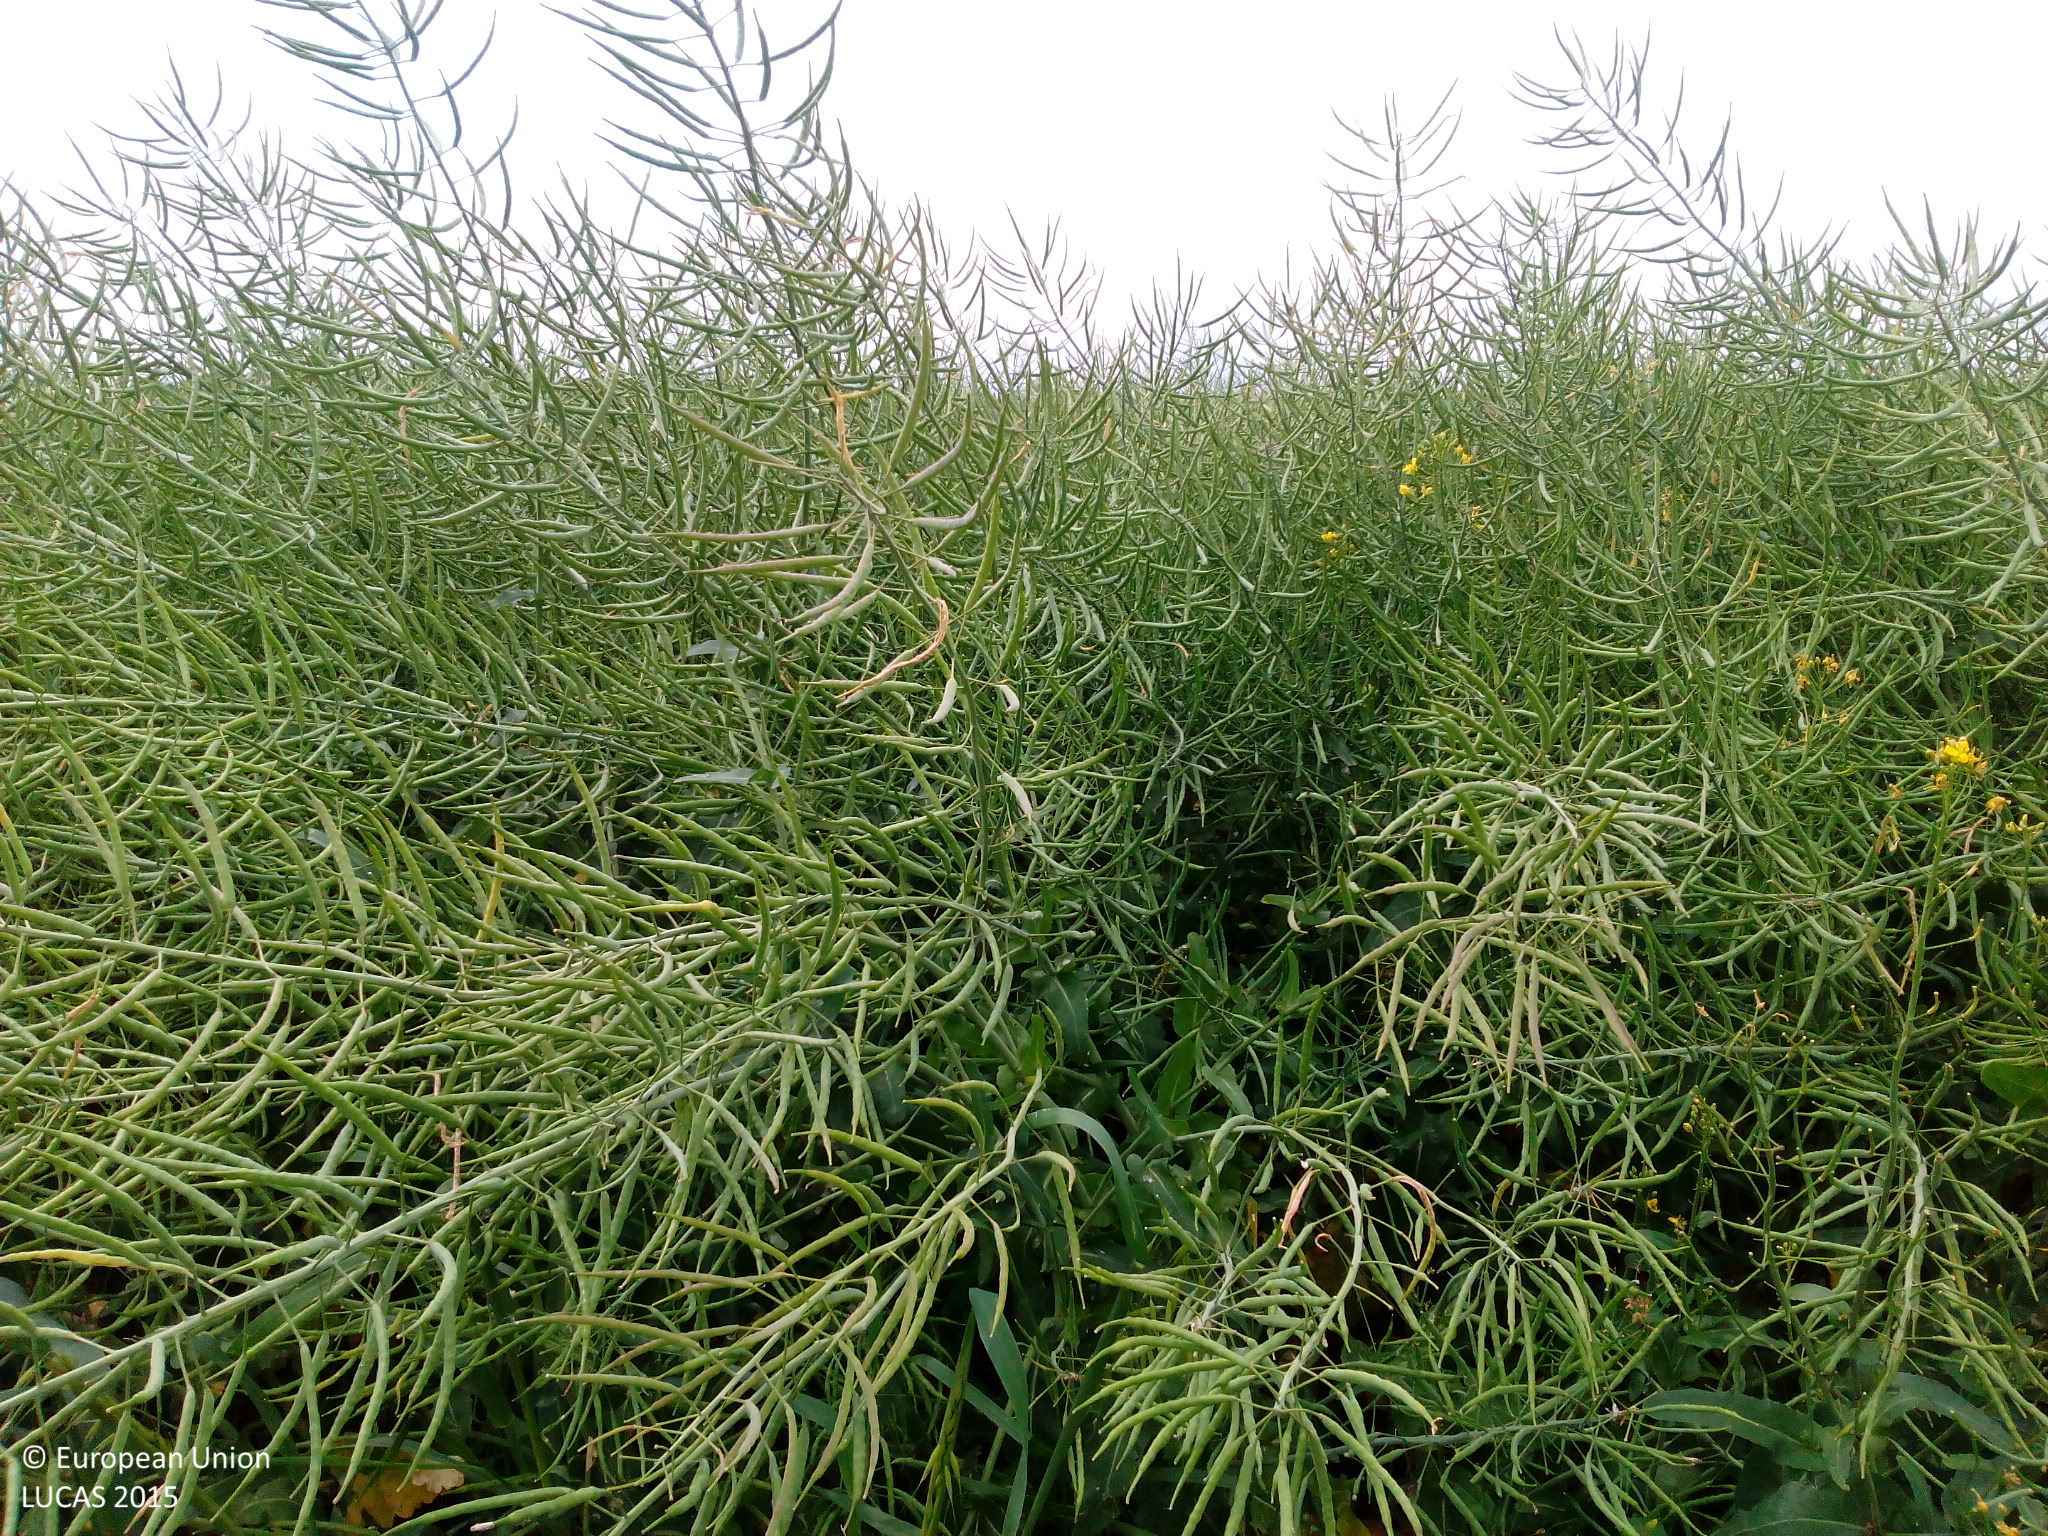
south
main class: Cropland
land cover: Rape and turnip rape
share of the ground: > 75 %
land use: Agriculture (excluding fallow land and kitchen gardens)
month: June
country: DE
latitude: 48.9777
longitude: 12.0898
